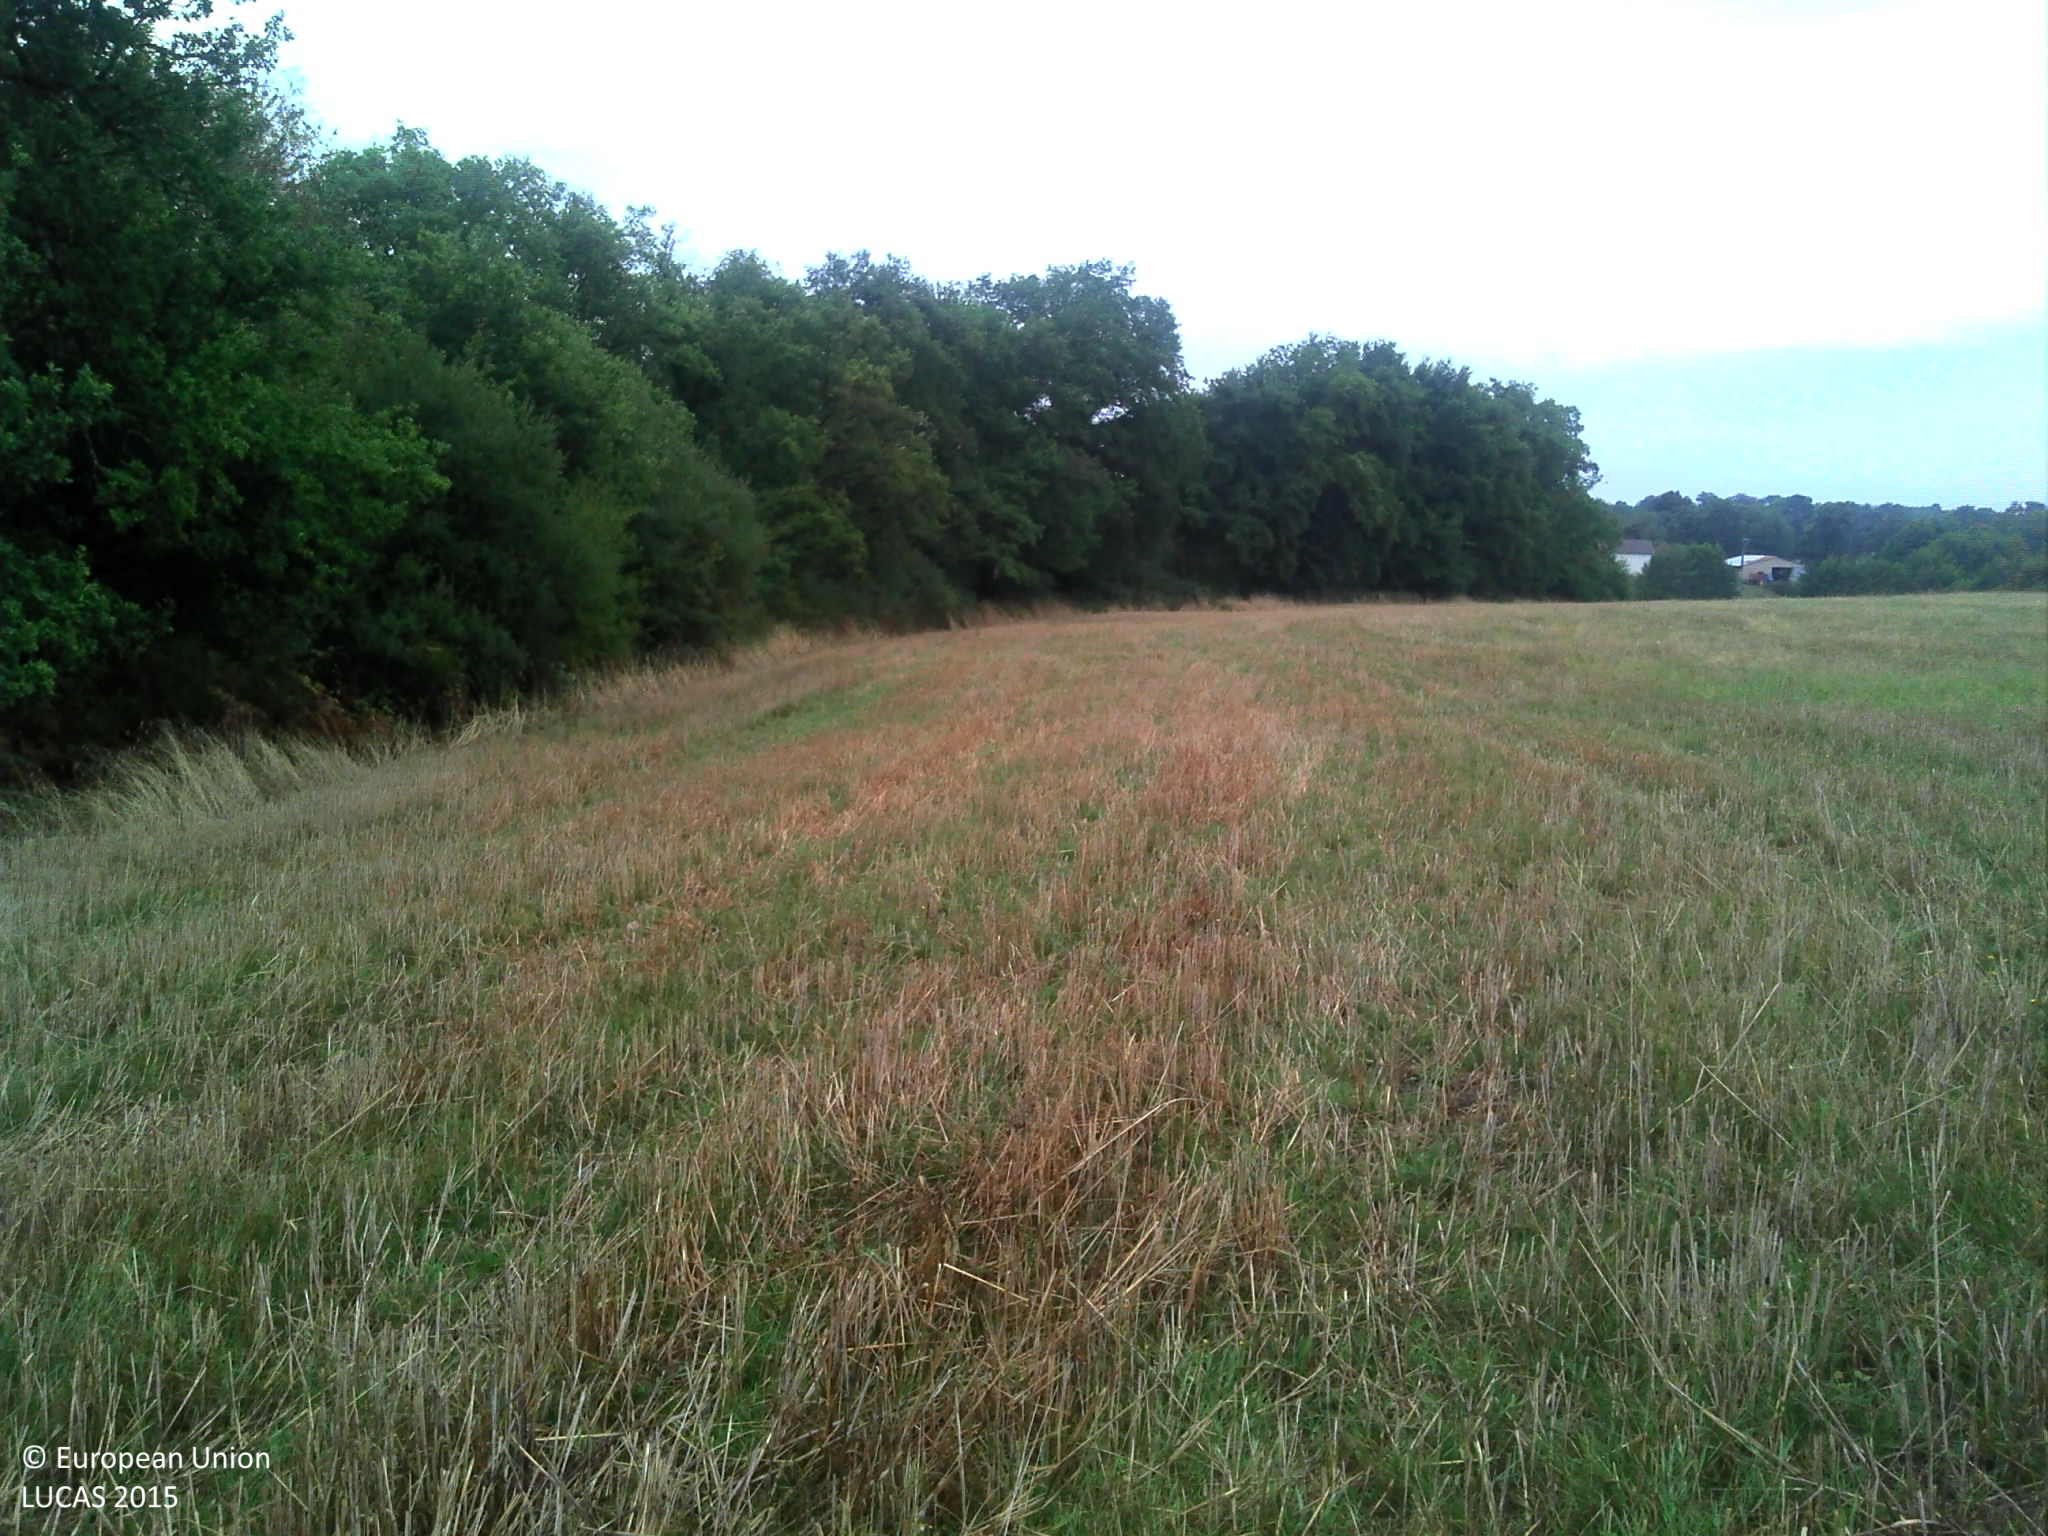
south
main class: Cropland
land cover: Barley
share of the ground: > 75 %
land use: Agriculture (excluding fallow land and kitchen gardens)
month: August
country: FR
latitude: 46.0020
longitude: 0.9360
